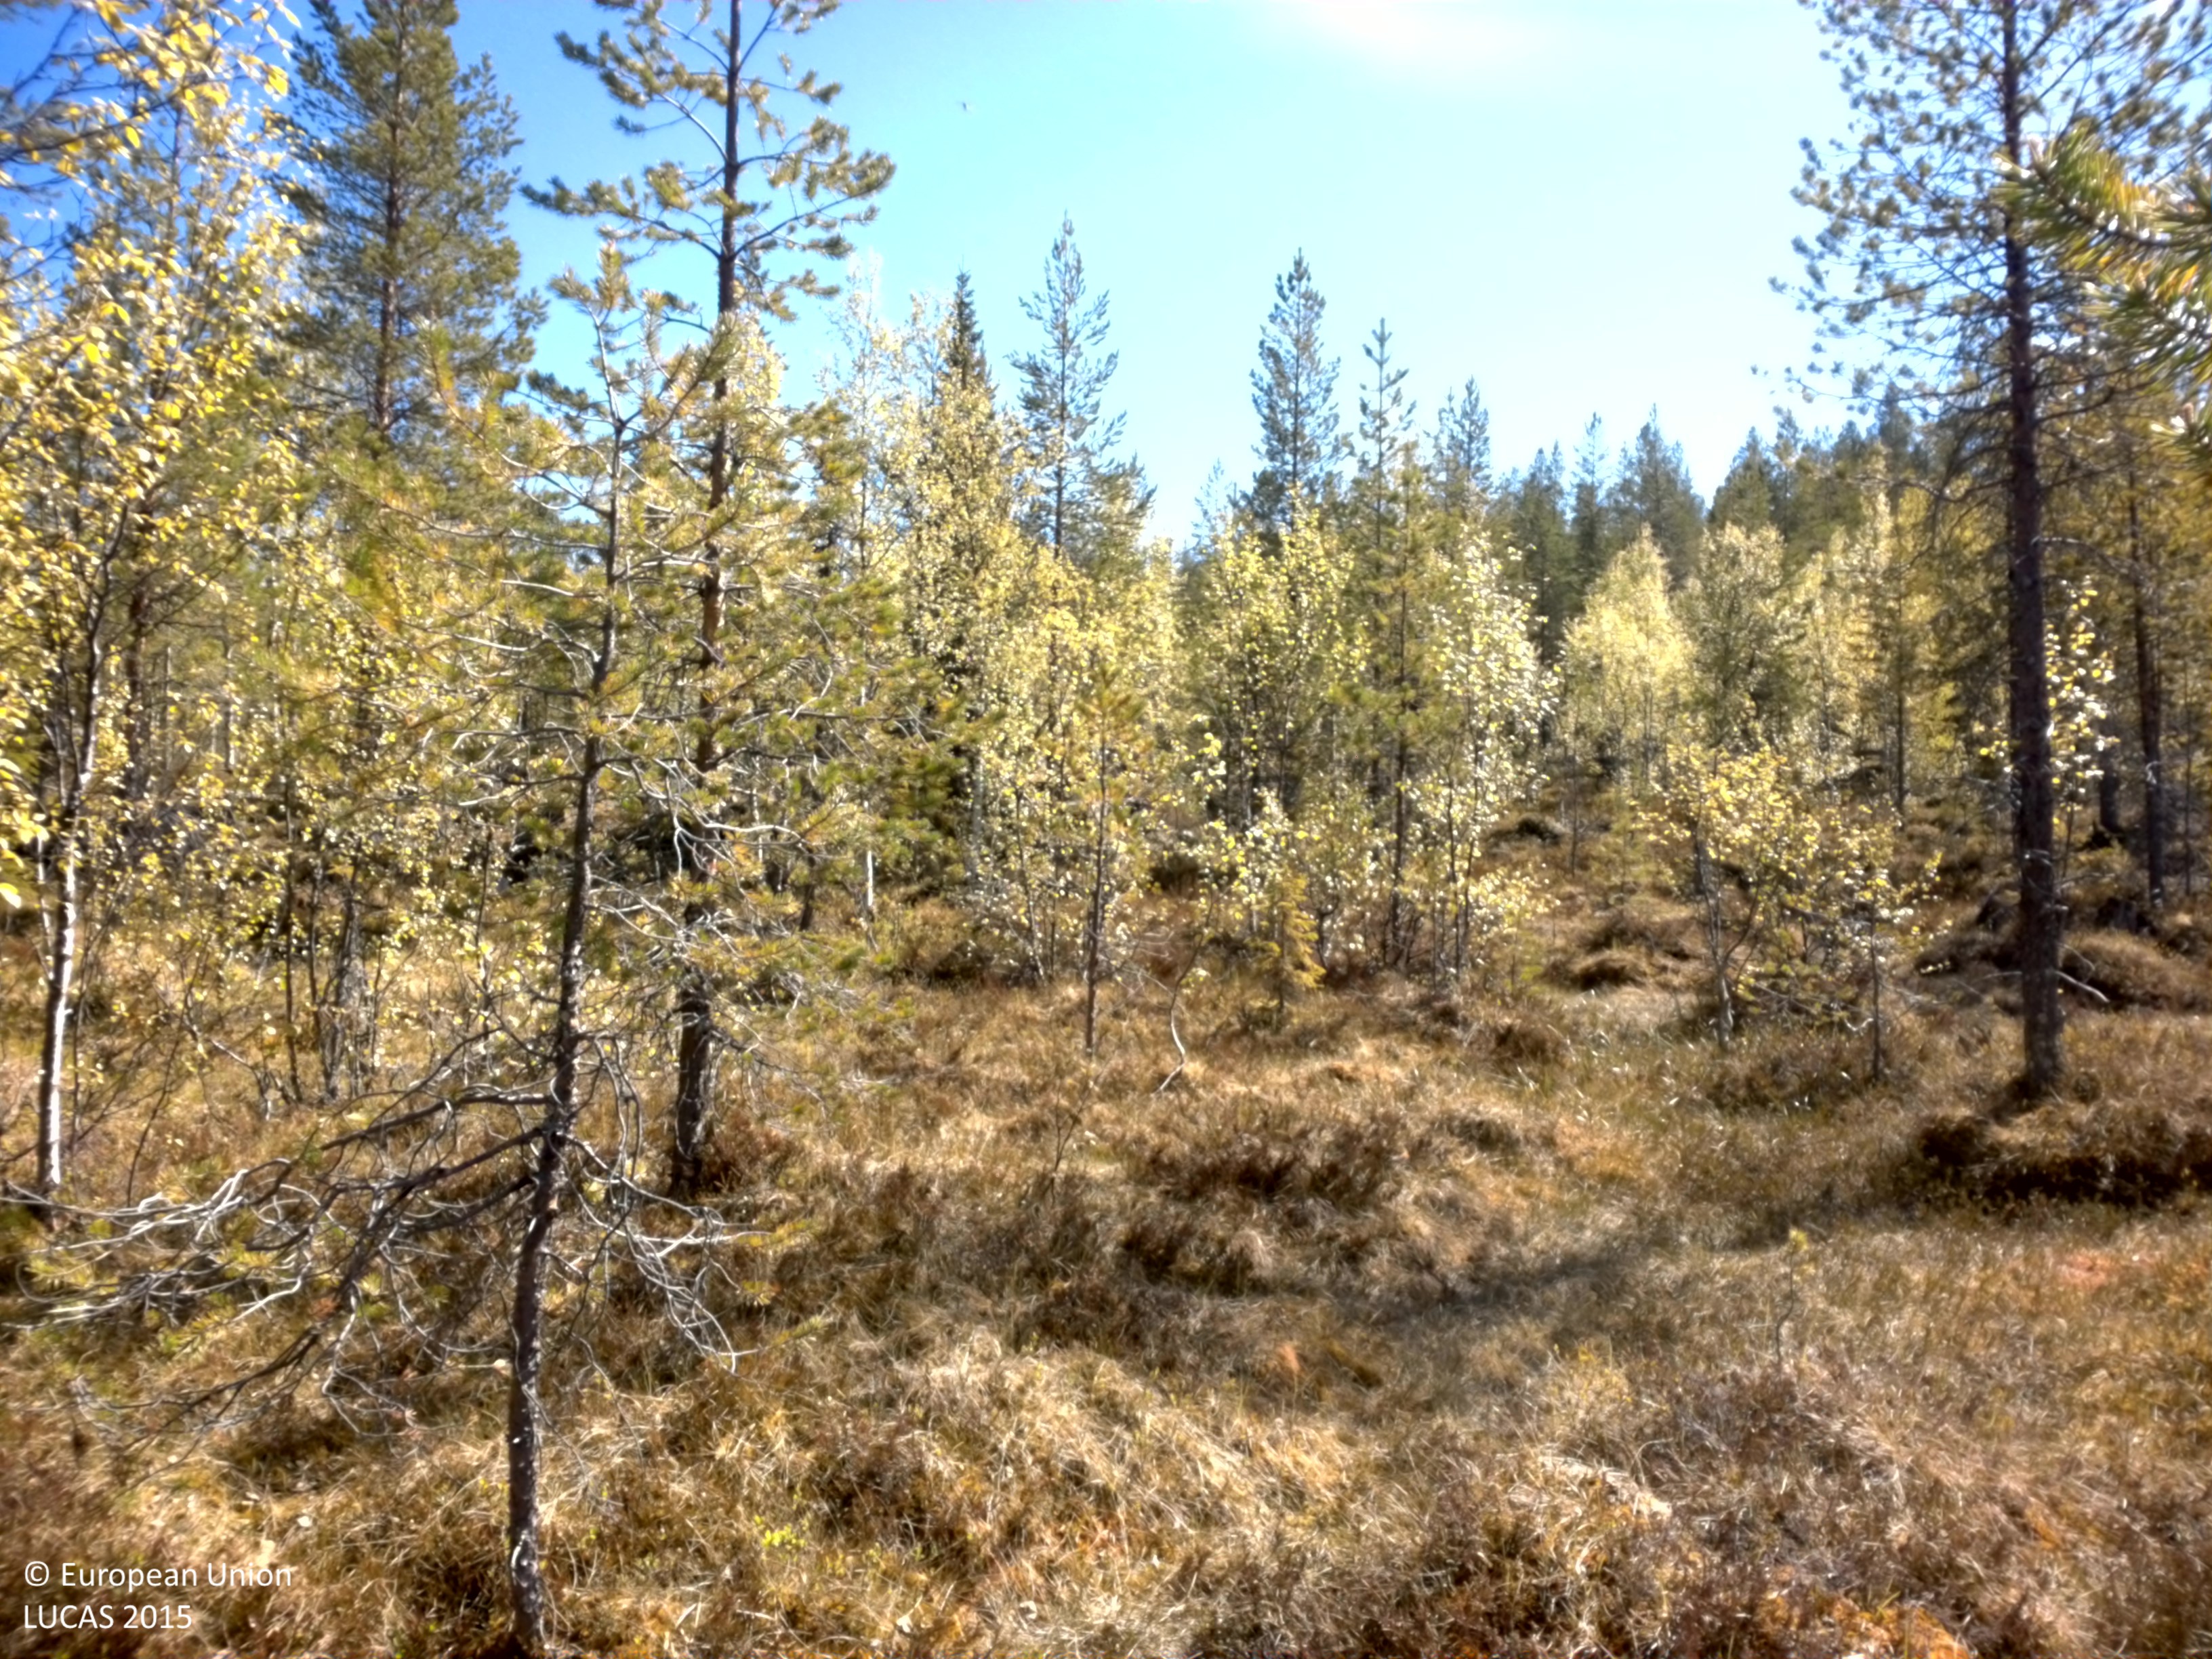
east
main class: Woodland
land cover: Pine dominated mixed woodland
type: boreal forest
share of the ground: 25 - 50 %
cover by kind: coniferous forest trees 30 %, herbaceous plants 20 %, broadleaved forest trees 15 %, lichens and mosses 15 %, shrubs 10 %, unconsolidated bare surface 10 %
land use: Forestry
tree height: > 5 m
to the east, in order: Pine dominated mixed woodland; Rocks and stones; Pine dominated mixed woodland; Rocks and stones; Pine dominated mixed woodland; Rocks and stones; Pine dominated mixed woodland; Rocks and stones; Pine dominated mixed woodland; Pine dominated coniferous woodland; Tracks; Rocks and stones; Pine dominated coniferous woodland; Tracks; Pine dominated coniferous woodland; Tracks
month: June
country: SE
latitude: 64.3401
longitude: 17.2746
